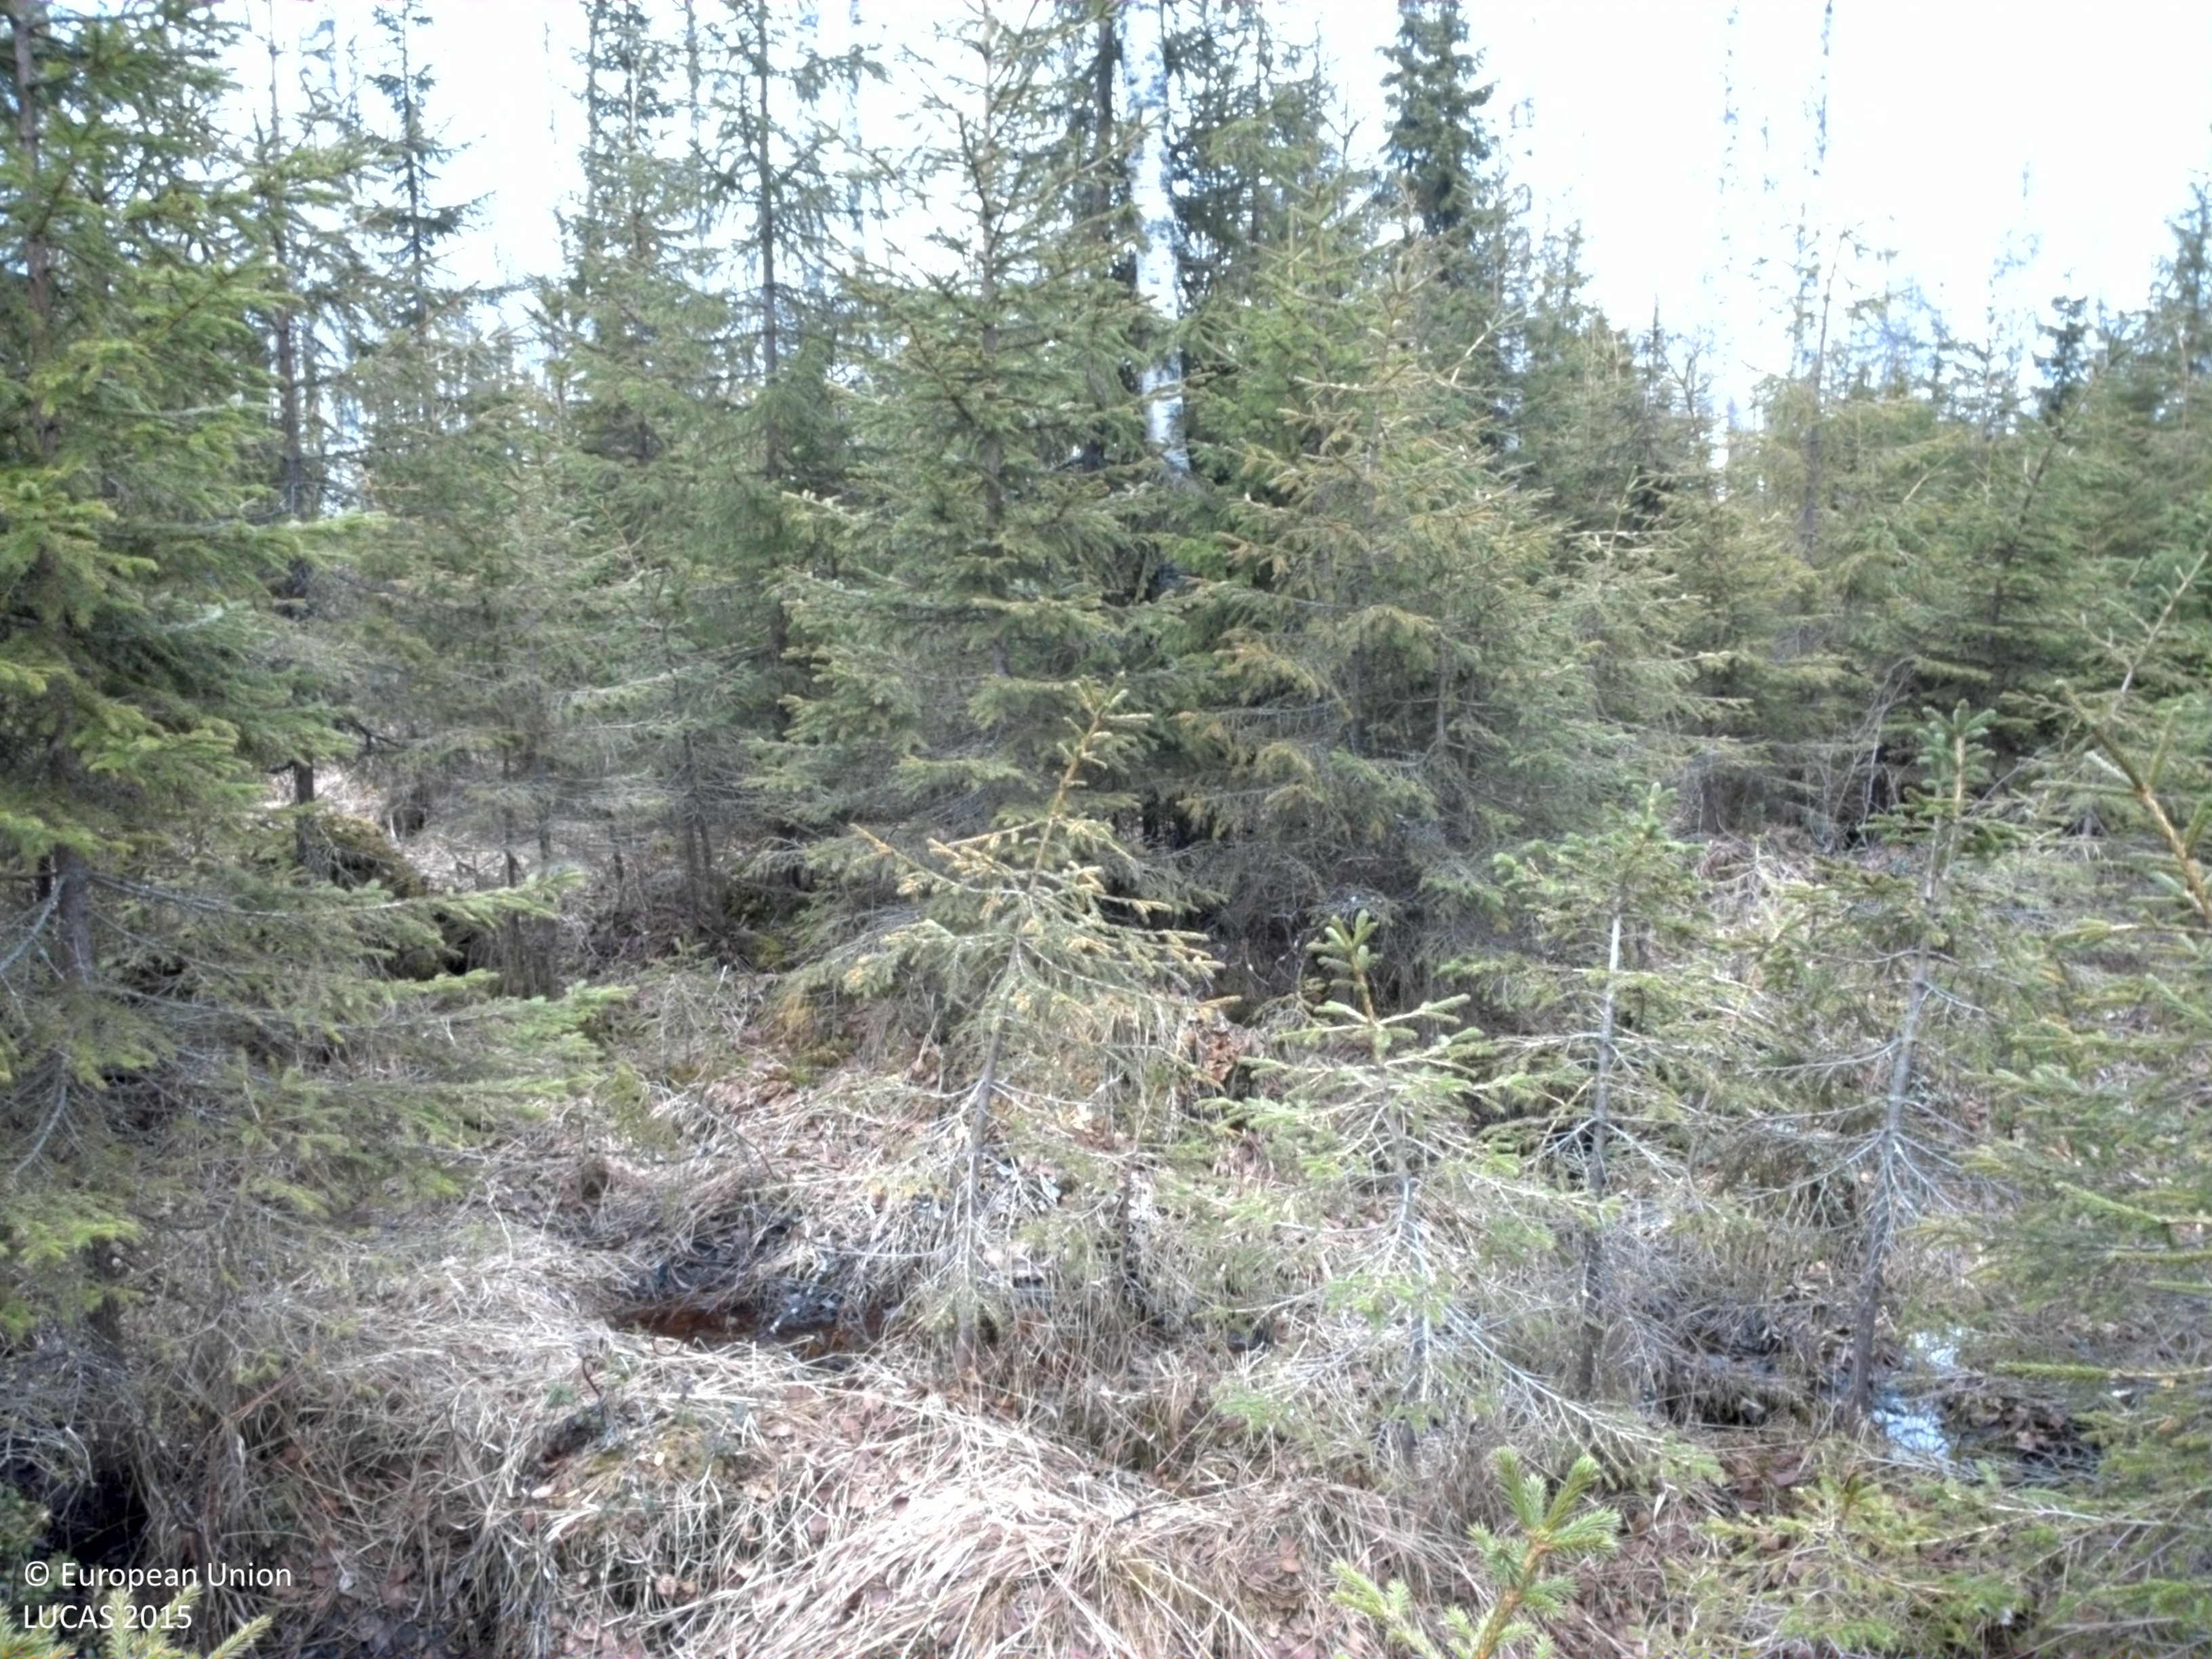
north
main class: Woodland
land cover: Spruce dominated mixed woodland
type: boreal forest
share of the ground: > 75 %
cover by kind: coniferous forest trees 60 %, broadleaved forest trees 20 %, herbaceous plants 10 %, shrubs 5 %, lichens and mosses 5 %
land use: Forestry
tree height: > 5 m
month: May
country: SE
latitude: 66.1309
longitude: 23.7909
